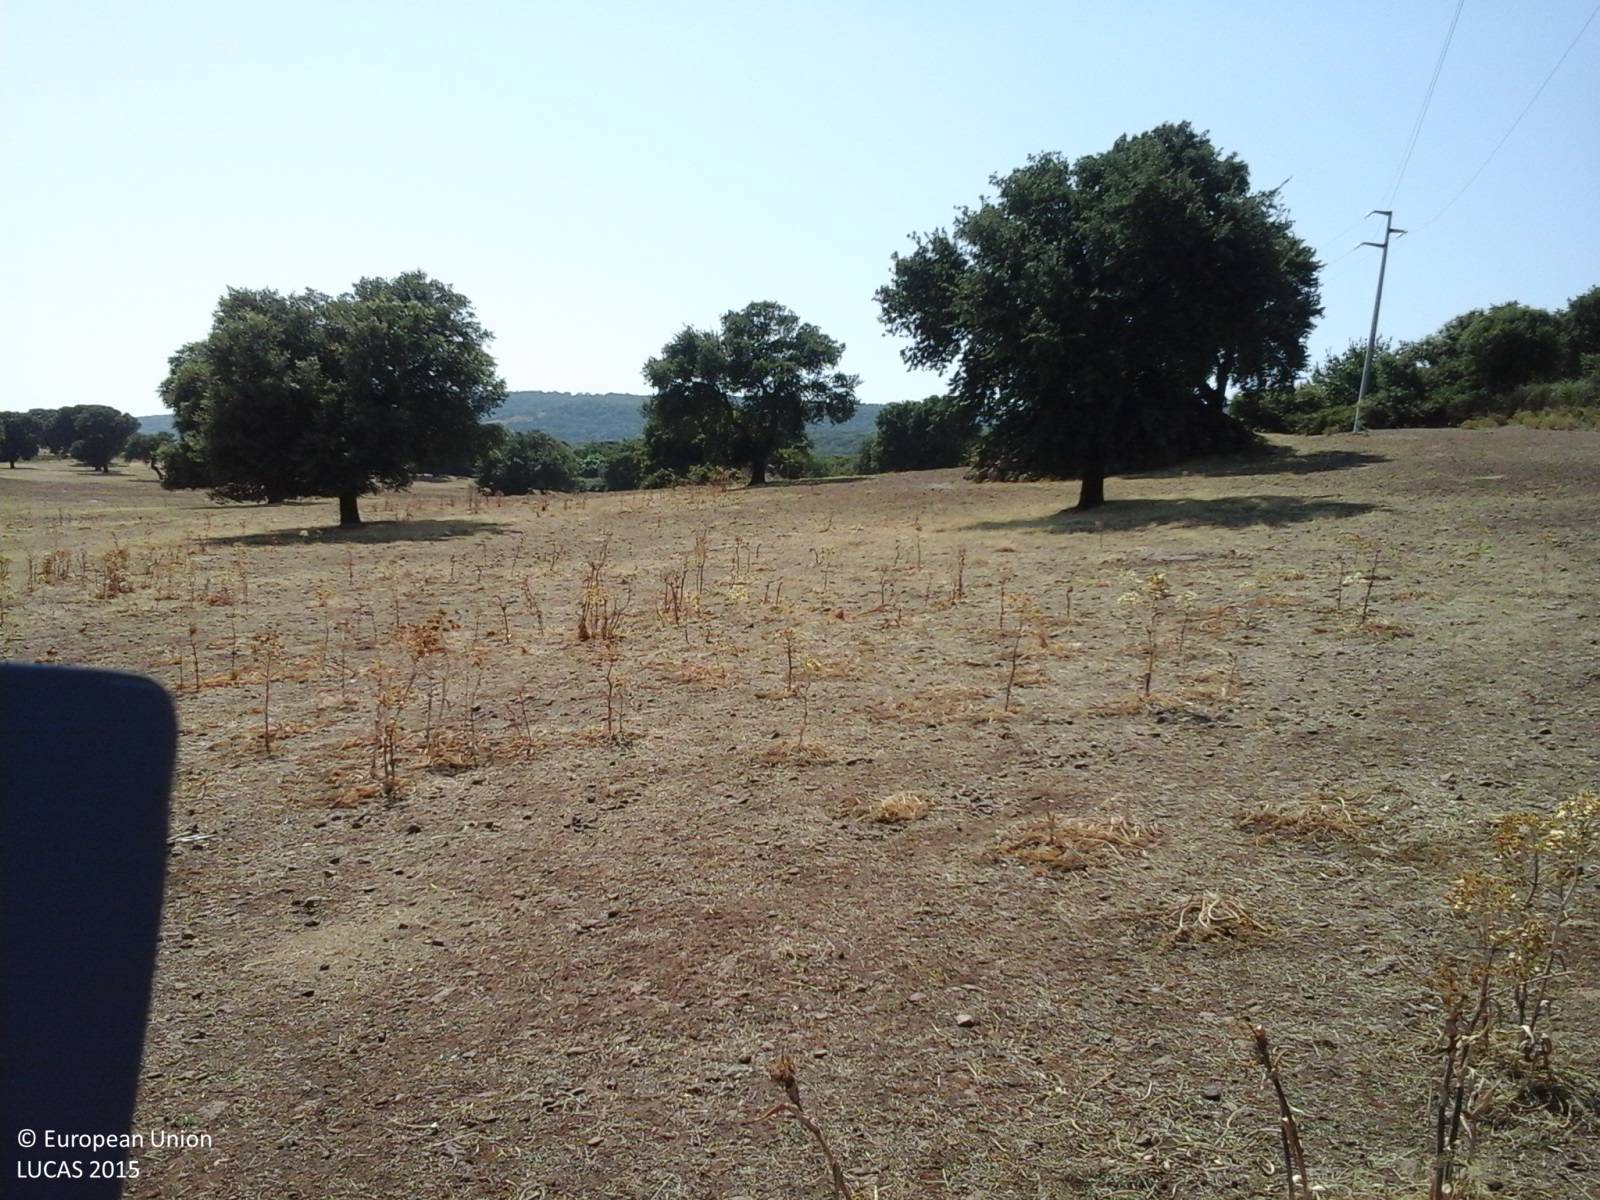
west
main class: Grassland
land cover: Grassland without tree/shrub cover
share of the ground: > 75 %
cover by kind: herbaceous plants 100 %
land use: Agriculture (excluding fallow land and kitchen gardens)
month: July
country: IT
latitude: 40.1130
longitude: 8.6346
